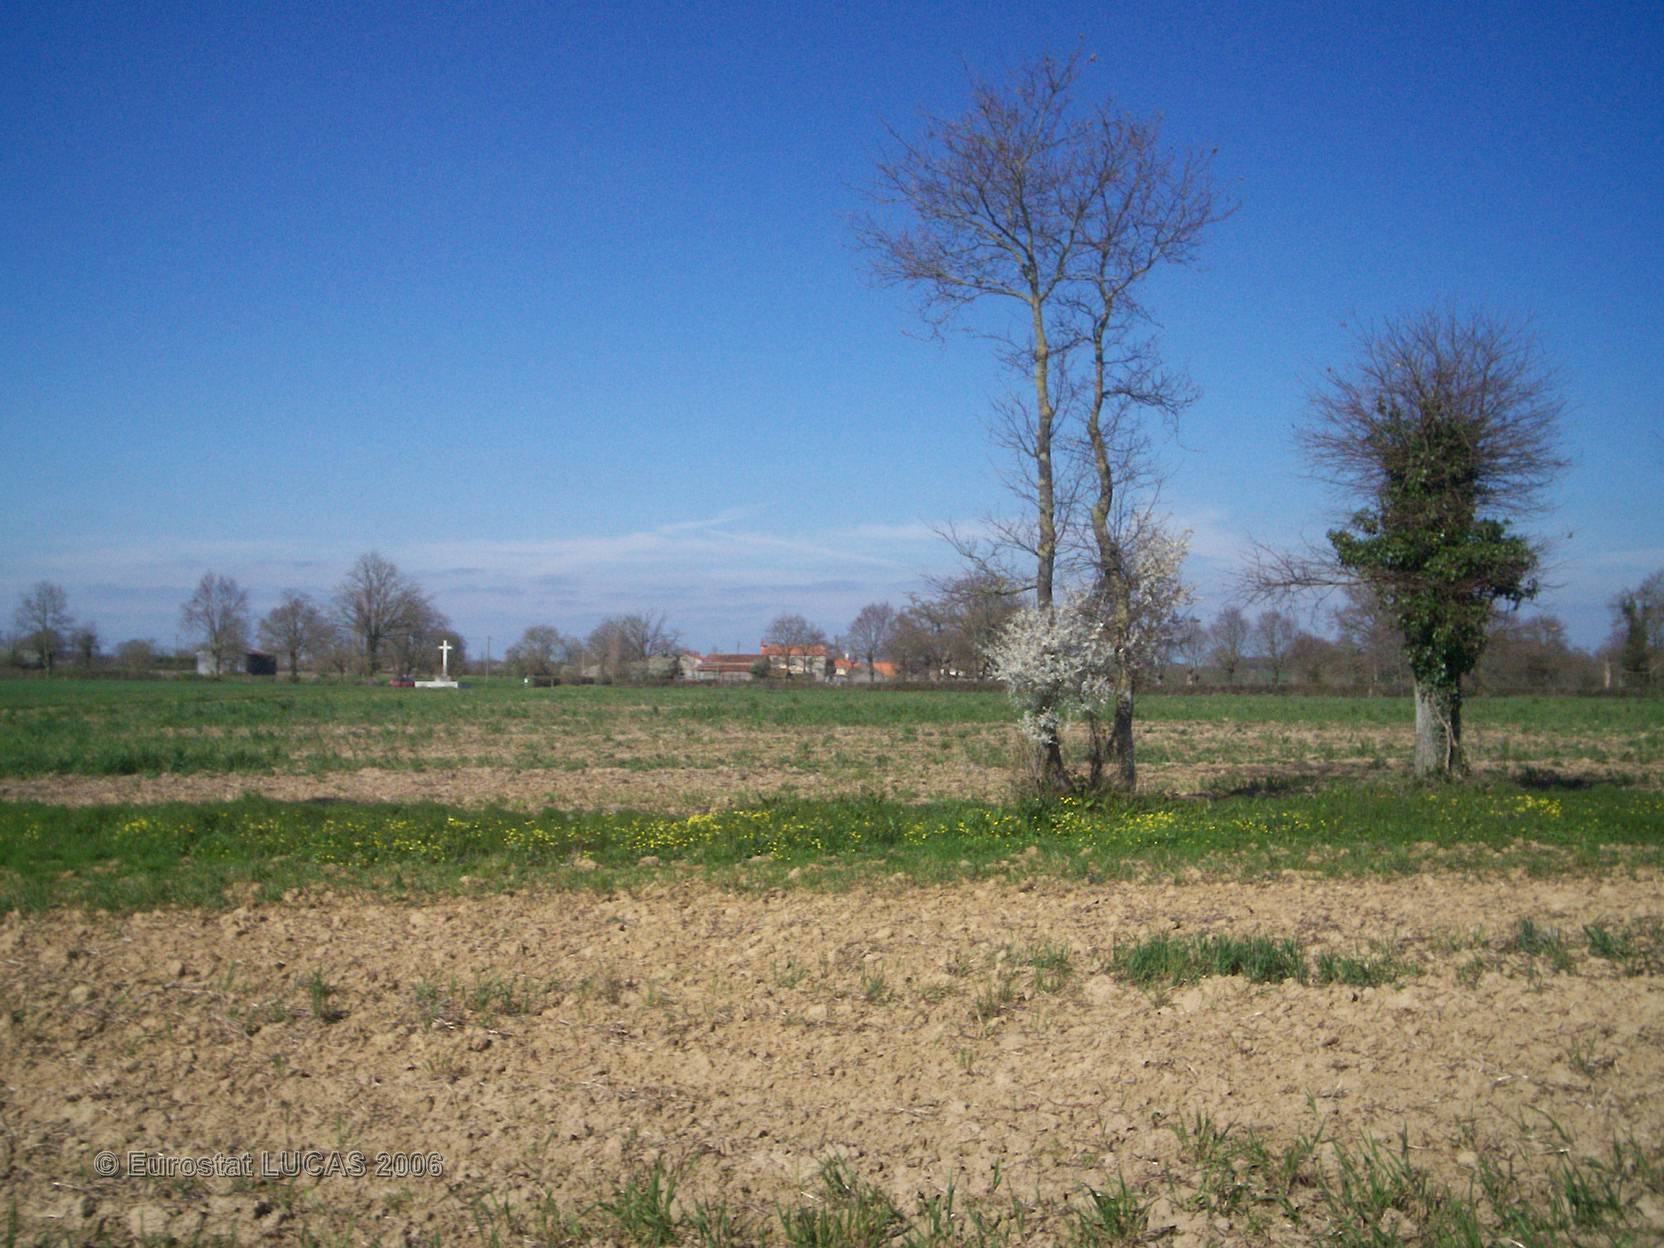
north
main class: Cropland
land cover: Maize
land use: Agriculture (excluding fallow land and kitchen gardens)
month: May
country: FR
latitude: 46.9352
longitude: -1.2678
